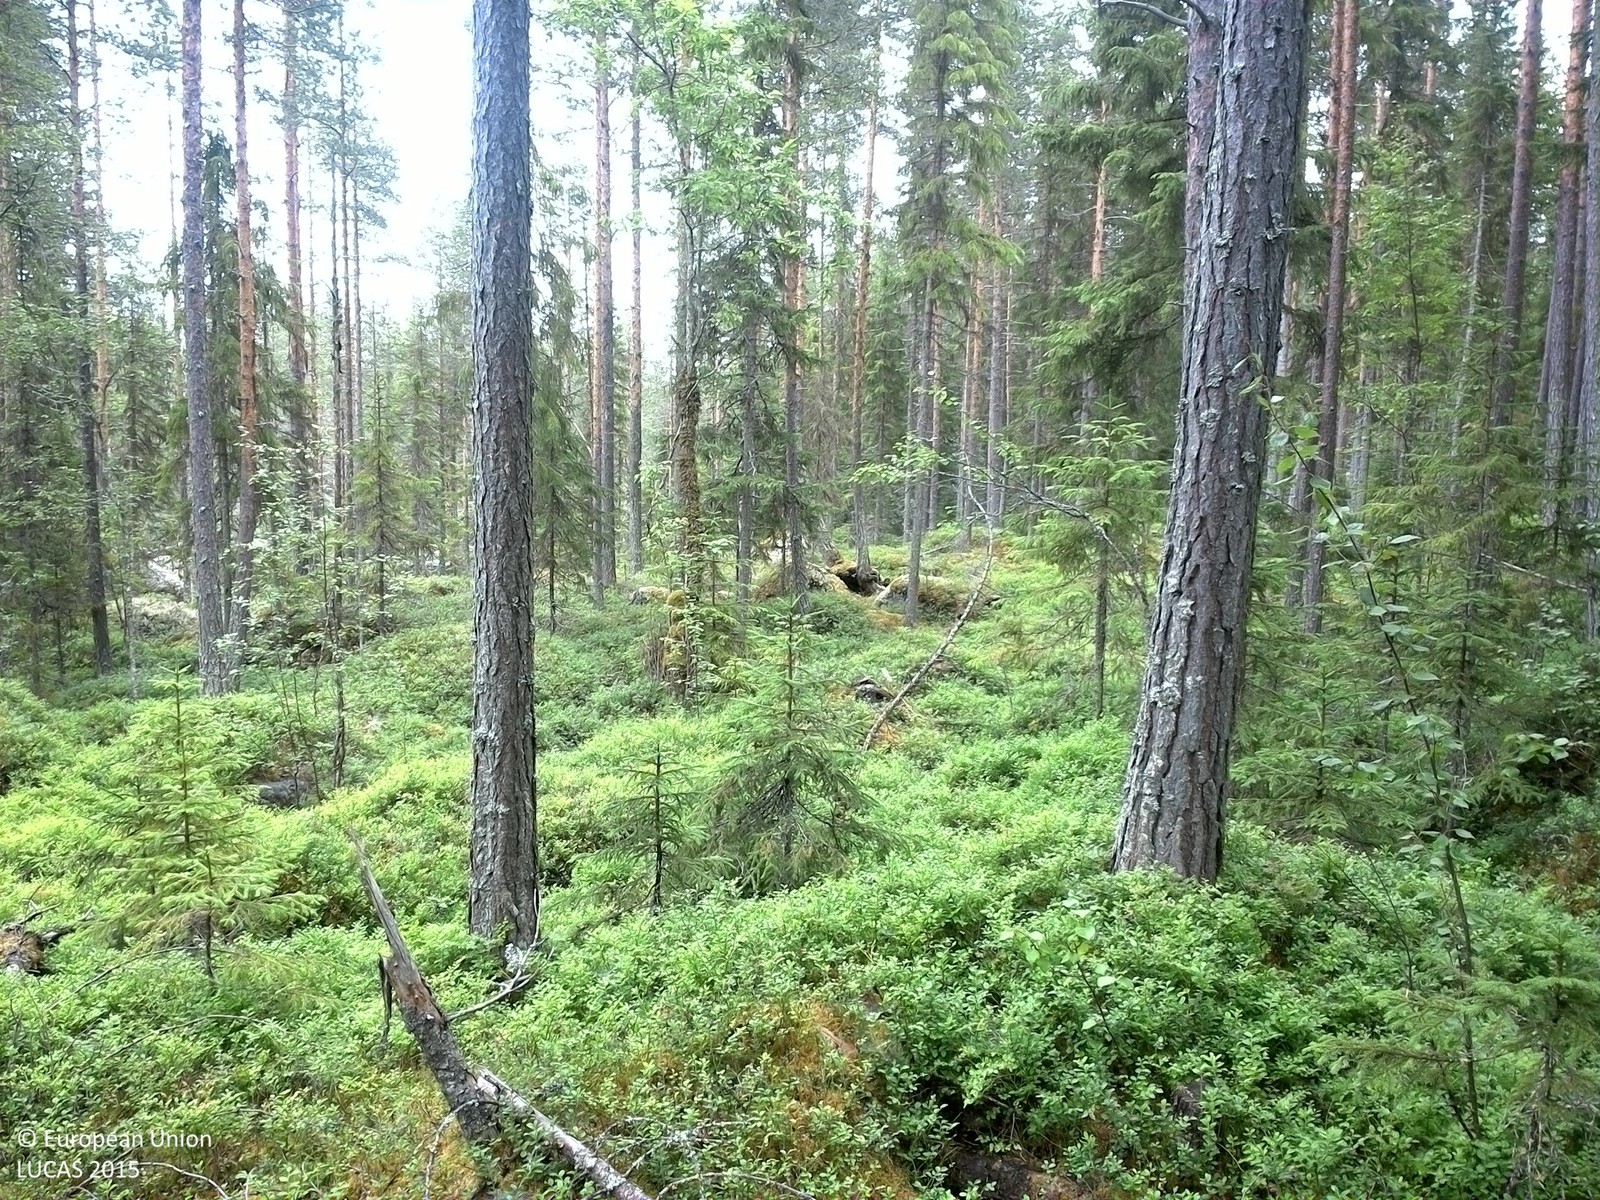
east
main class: Woodland
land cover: Pine dominated coniferous woodland
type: boreal forest
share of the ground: 25 - 50 %
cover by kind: coniferous forest trees 40 %, shrubs 35 %, lichens and mosses 15 %, broadleaved forest trees 5 %, consolidated bare surface 5 %
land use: Forestry
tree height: > 5 m
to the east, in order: Pine dominated coniferous woodland; Pine dominated mixed woodland; Rocks and stones; Pine dominated mixed woodland; Spruce dominated mixed woodland; Spruce dominated coniferous woodland; Spruce dominated mixed woodland
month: August
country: SE
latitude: 63.5676
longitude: 16.2760
